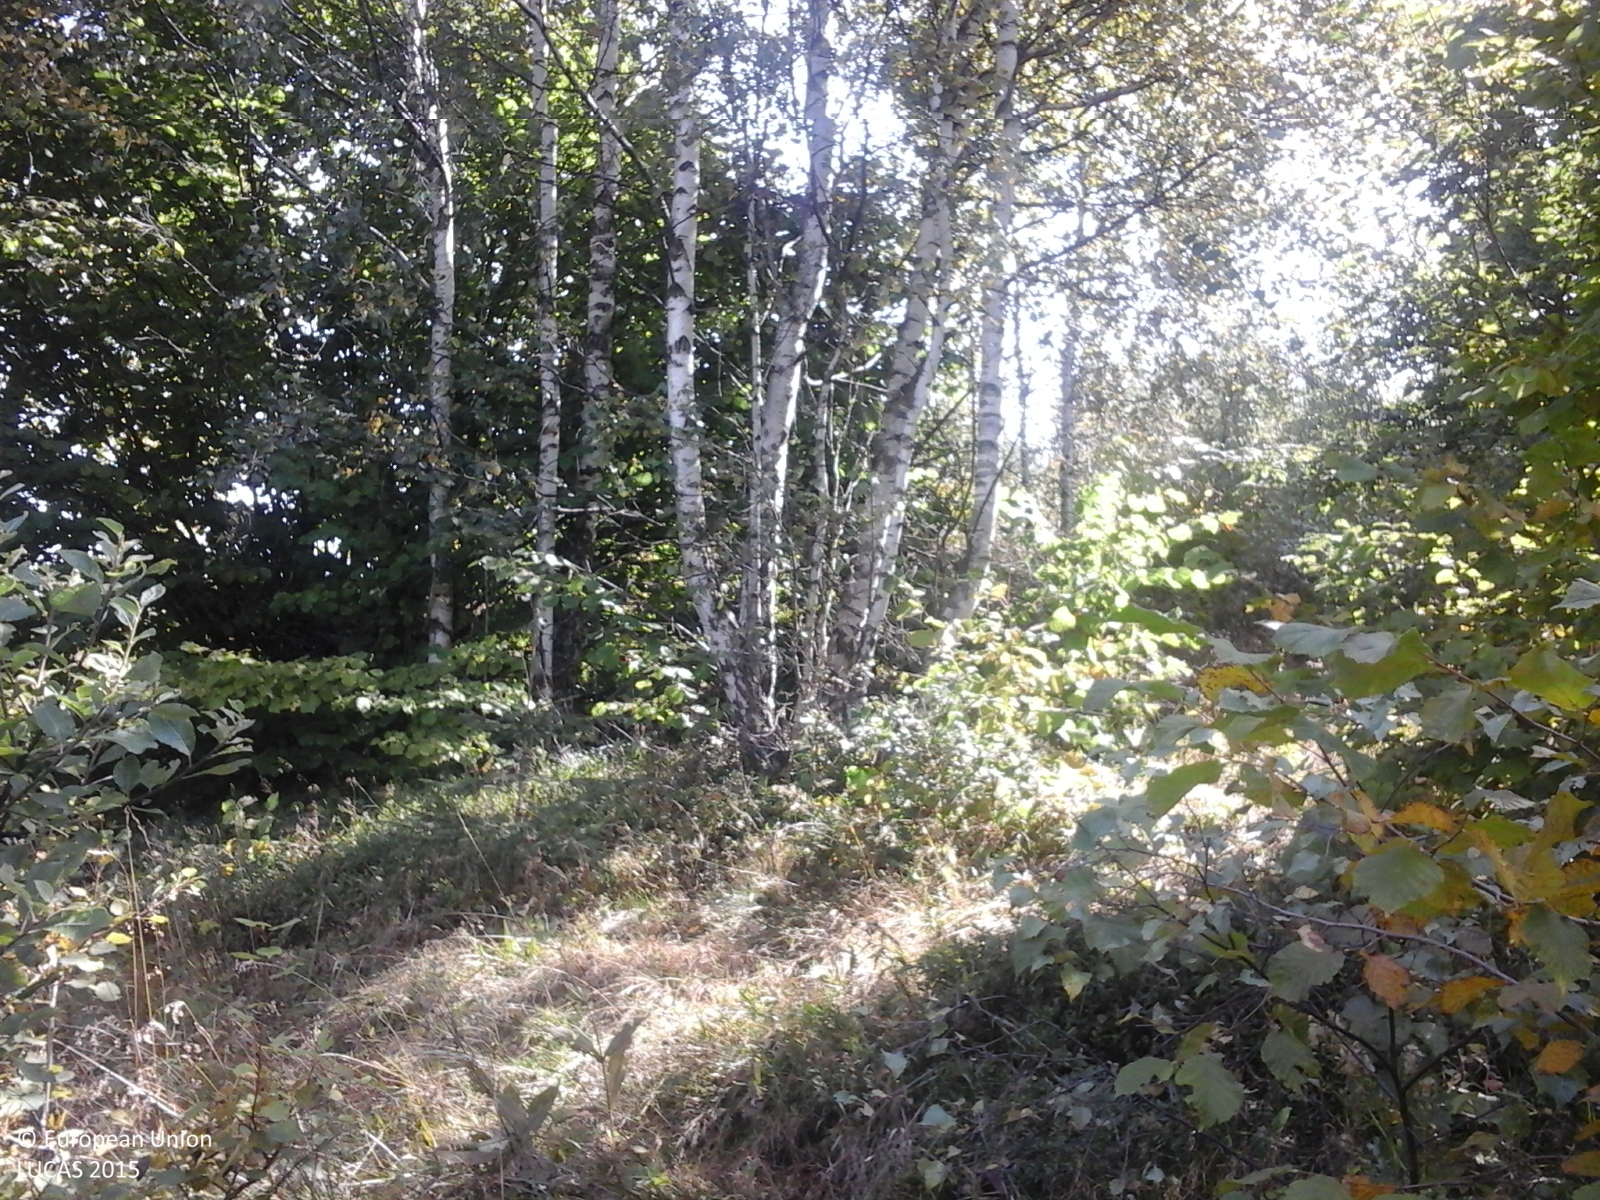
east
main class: Woodland
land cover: Spruce dominated mixed woodland
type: alpine coniferous forest
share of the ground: > 75 %
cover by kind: coniferous forest trees 50 %, broadleaved forest trees 40 %, shrubs 5 %, herbaceous plants 5 %
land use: Forestry
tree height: > 5 m
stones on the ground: < 10 %
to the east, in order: Spruce dominated mixed woodland; Grassland without tree/shrub cover; Abandoned hedges; Tracks; Grassland with sparse tree/shrub cover; Fences; Grassland without tree/shrub cover; Broadleaved woodland
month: September
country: RO
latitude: 46.7290
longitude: 23.0818
